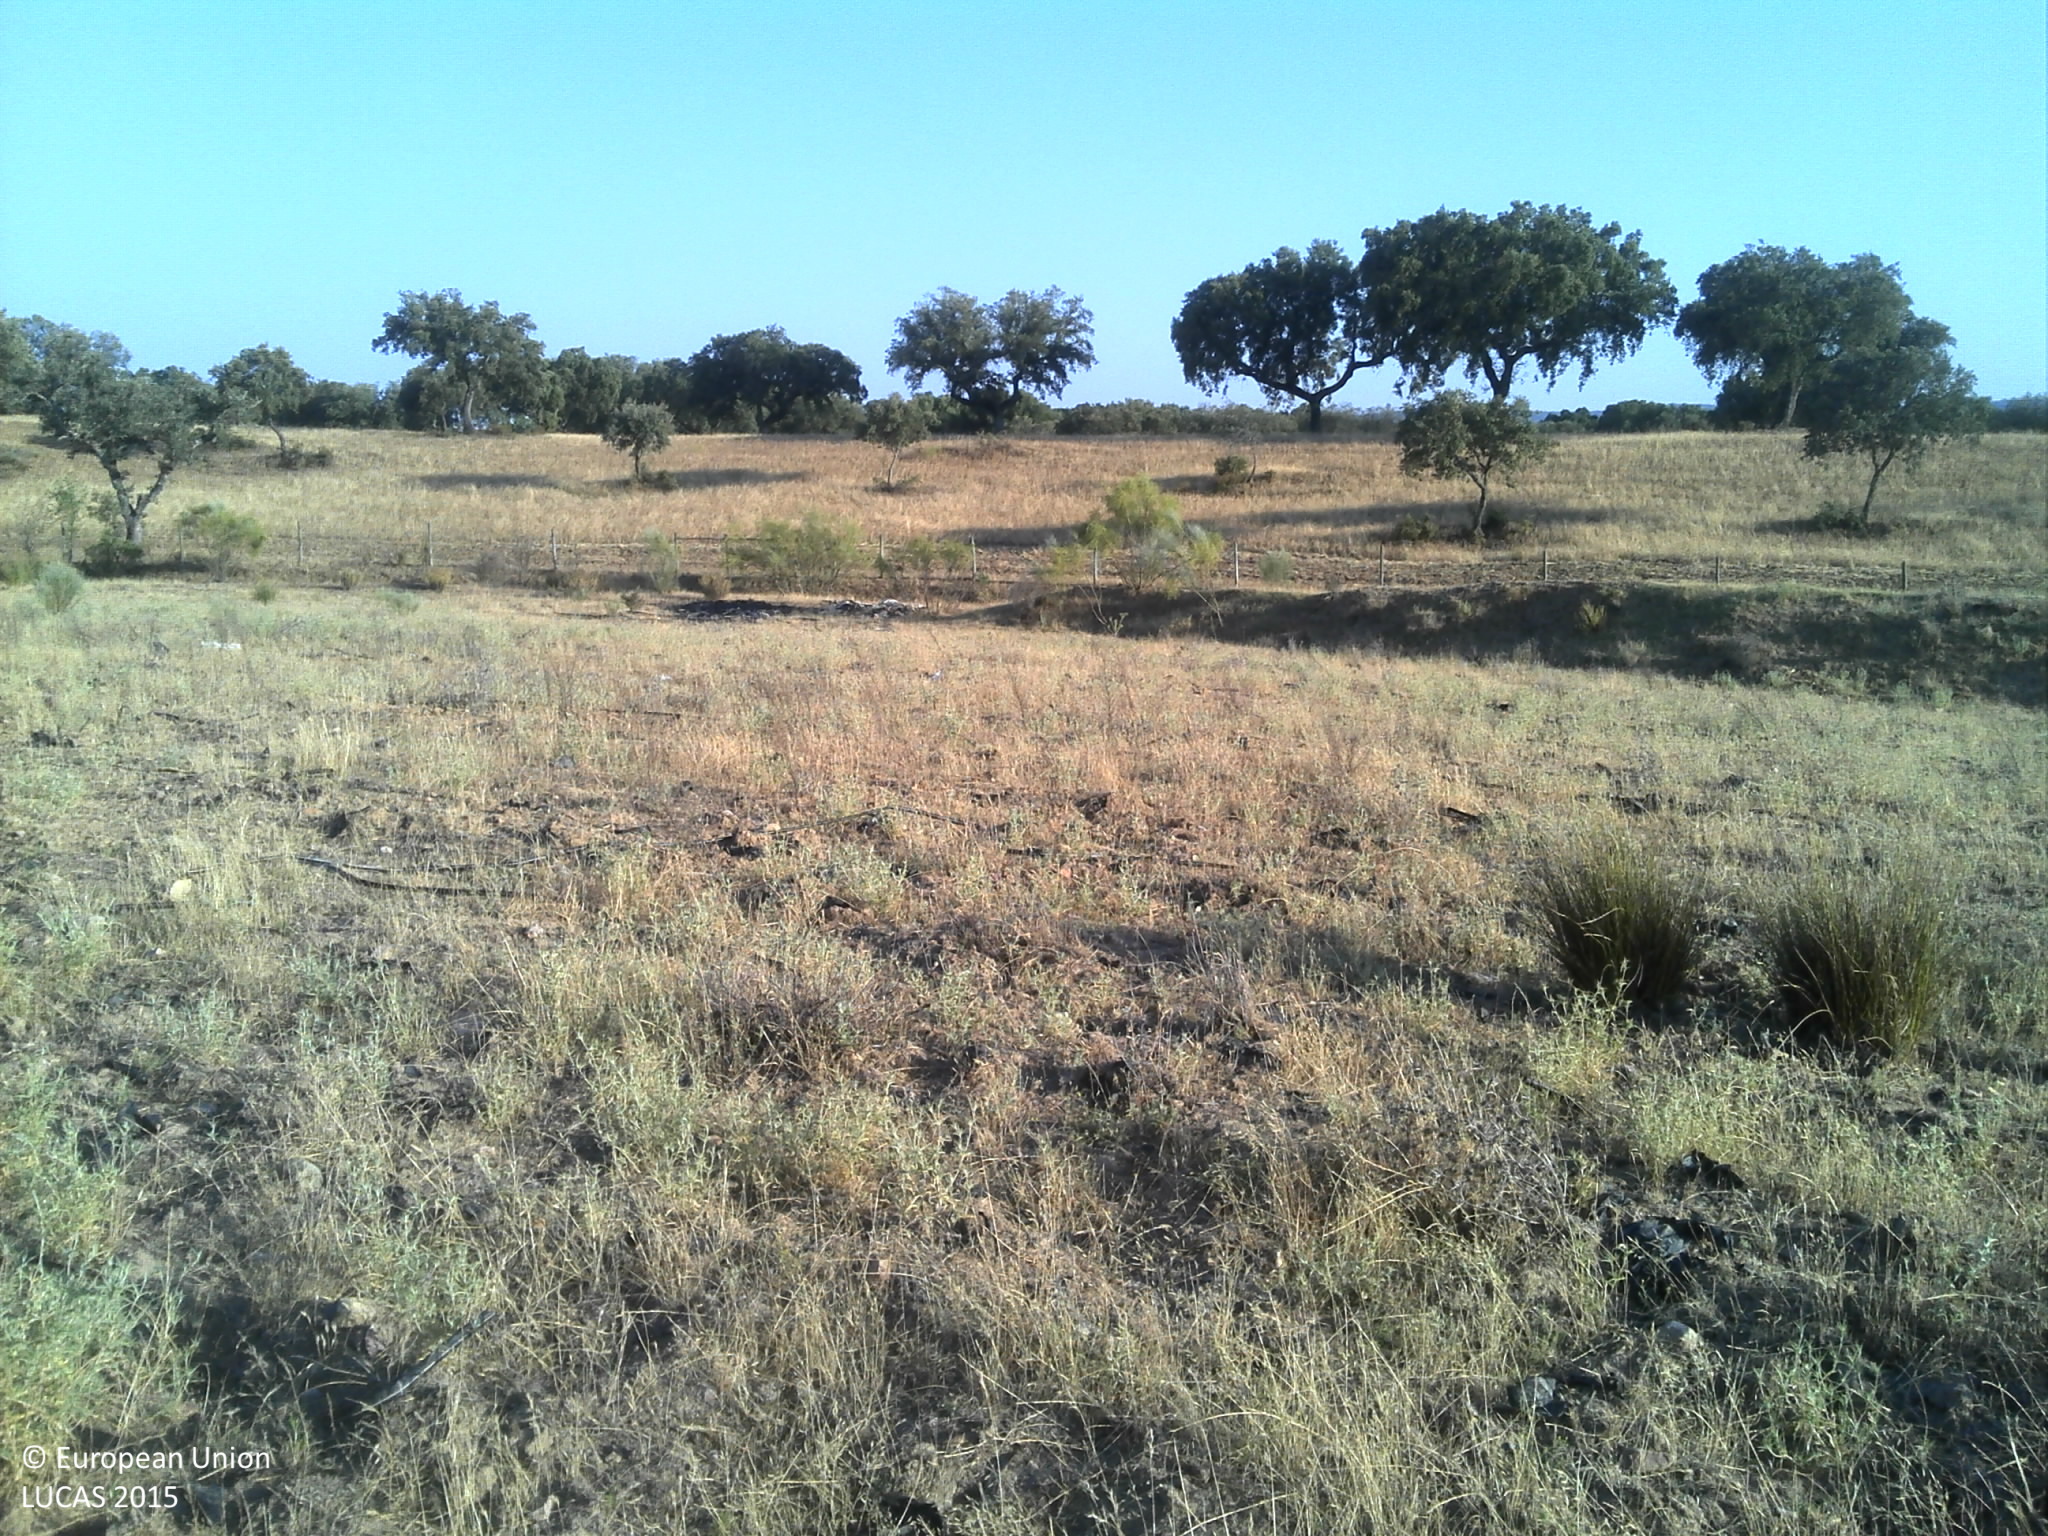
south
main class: Grassland
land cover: Grassland with sparse tree/shrub cover
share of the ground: 50 - 75 %
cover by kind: herbaceous plants 75 %, unconsolidated bare surface 15 %, broadleaved forest trees 5 %, shrubs 5 %
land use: Agriculture (excluding fallow land and kitchen gardens)
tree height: > 5 m
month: June
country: PT
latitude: 39.8102
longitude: -7.2763
